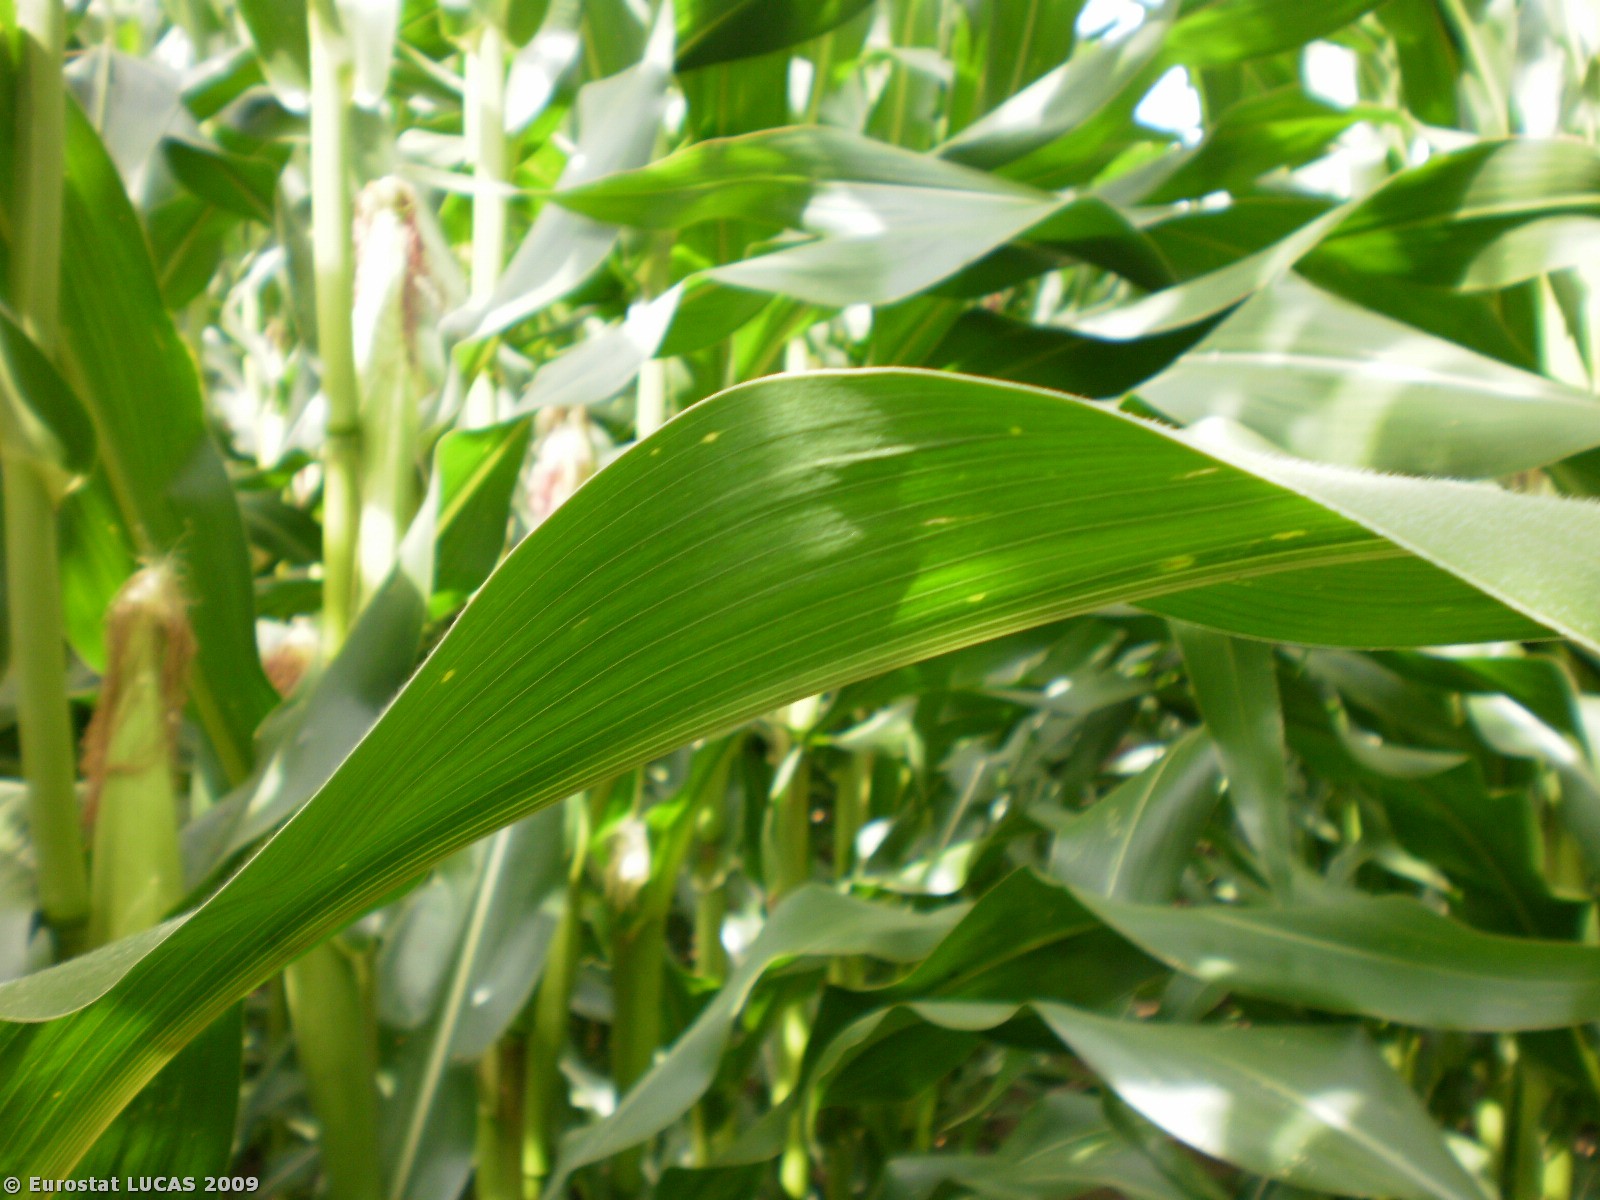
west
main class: Cropland
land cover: Maize
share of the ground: > 75 %
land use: Agriculture (excluding fallow land and kitchen gardens)
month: July
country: BE
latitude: 50.7885
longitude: 2.8255
